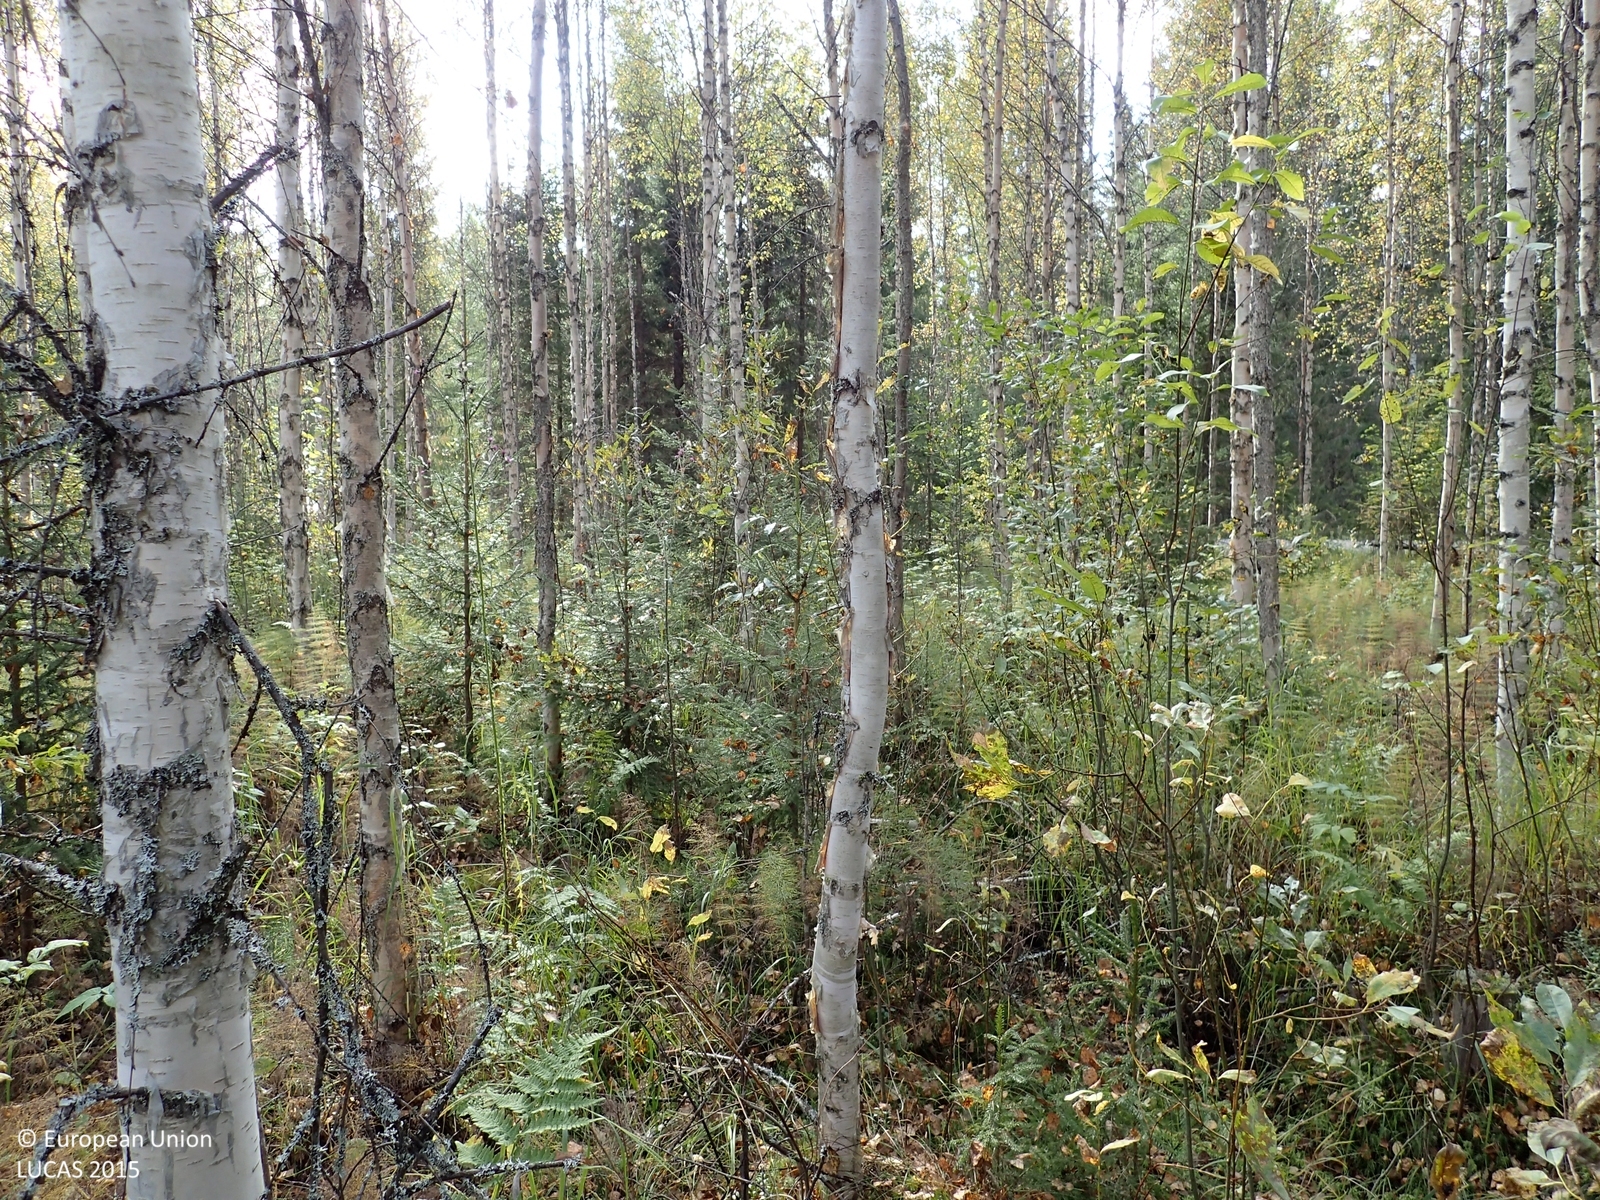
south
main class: Woodland
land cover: Broadleaved woodland
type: non-riverine alder, birch or aspen forest
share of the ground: > 75 %
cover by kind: broadleaved forest trees 70 %, herbaceous plants 15 %, coniferous forest trees 5 %, shrubs 5 %, lichens and mosses 5 %
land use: Forestry
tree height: > 5 m
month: September
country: FI
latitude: 62.9464
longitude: 25.4989
